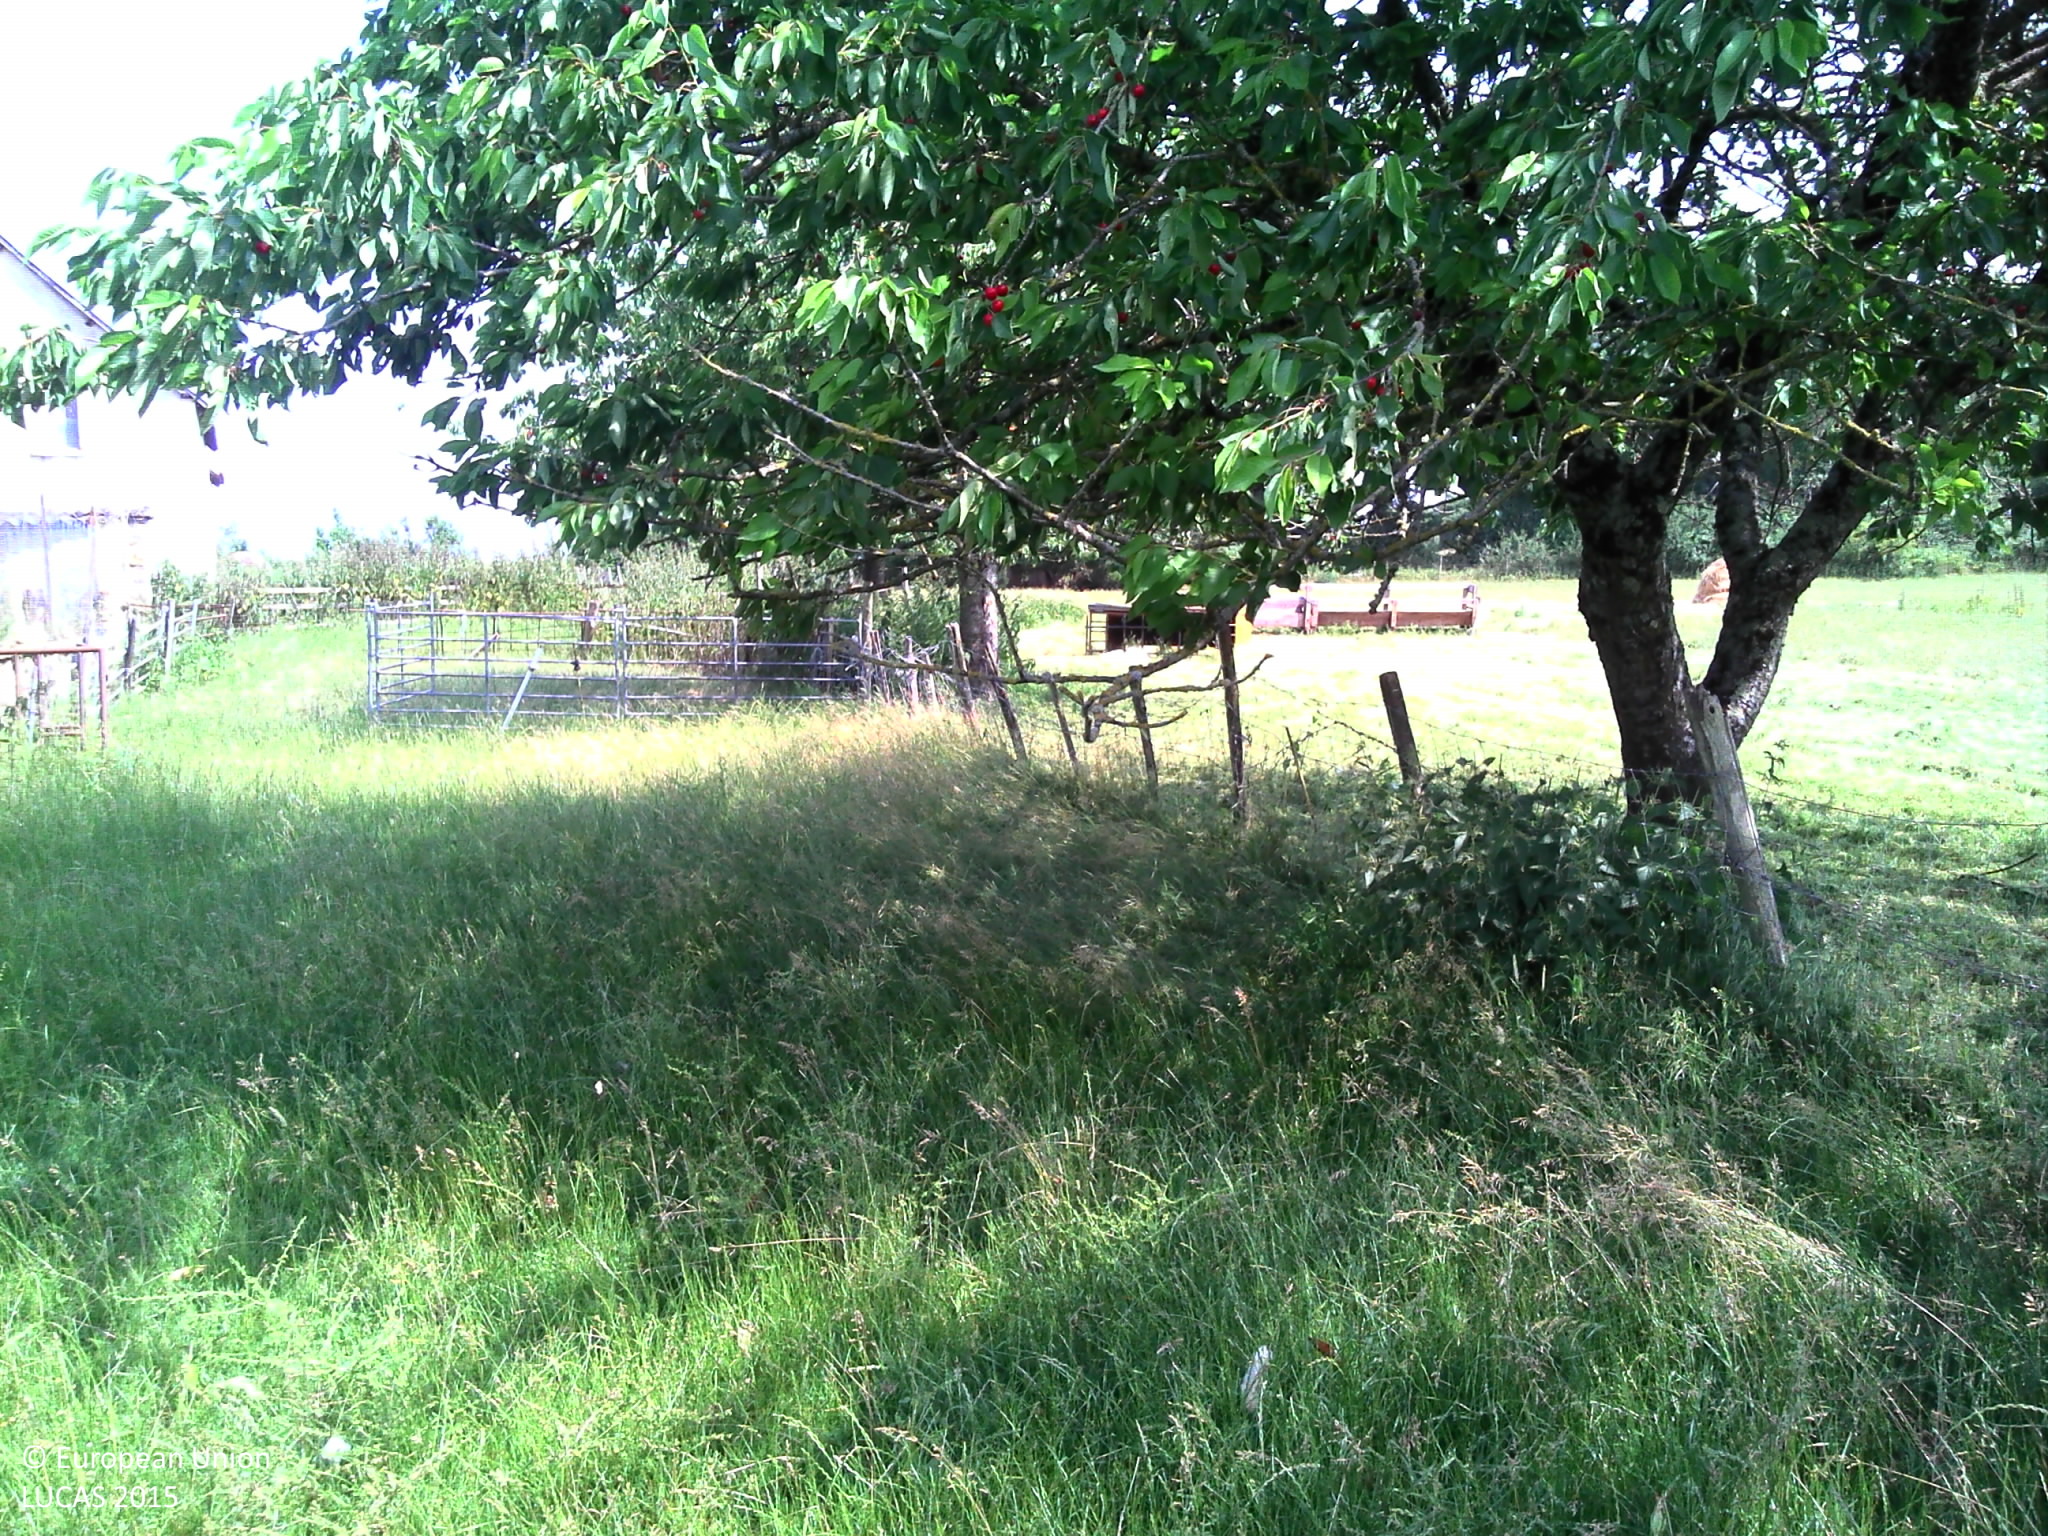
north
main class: Grassland
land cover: Grassland with sparse tree/shrub cover
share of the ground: > 75 %
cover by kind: herbaceous plants 95 %, broadleaved forest trees 5 %
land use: Agriculture (excluding fallow land and kitchen gardens)
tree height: > 5 m
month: June
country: FR
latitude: 46.6649
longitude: 0.8488
